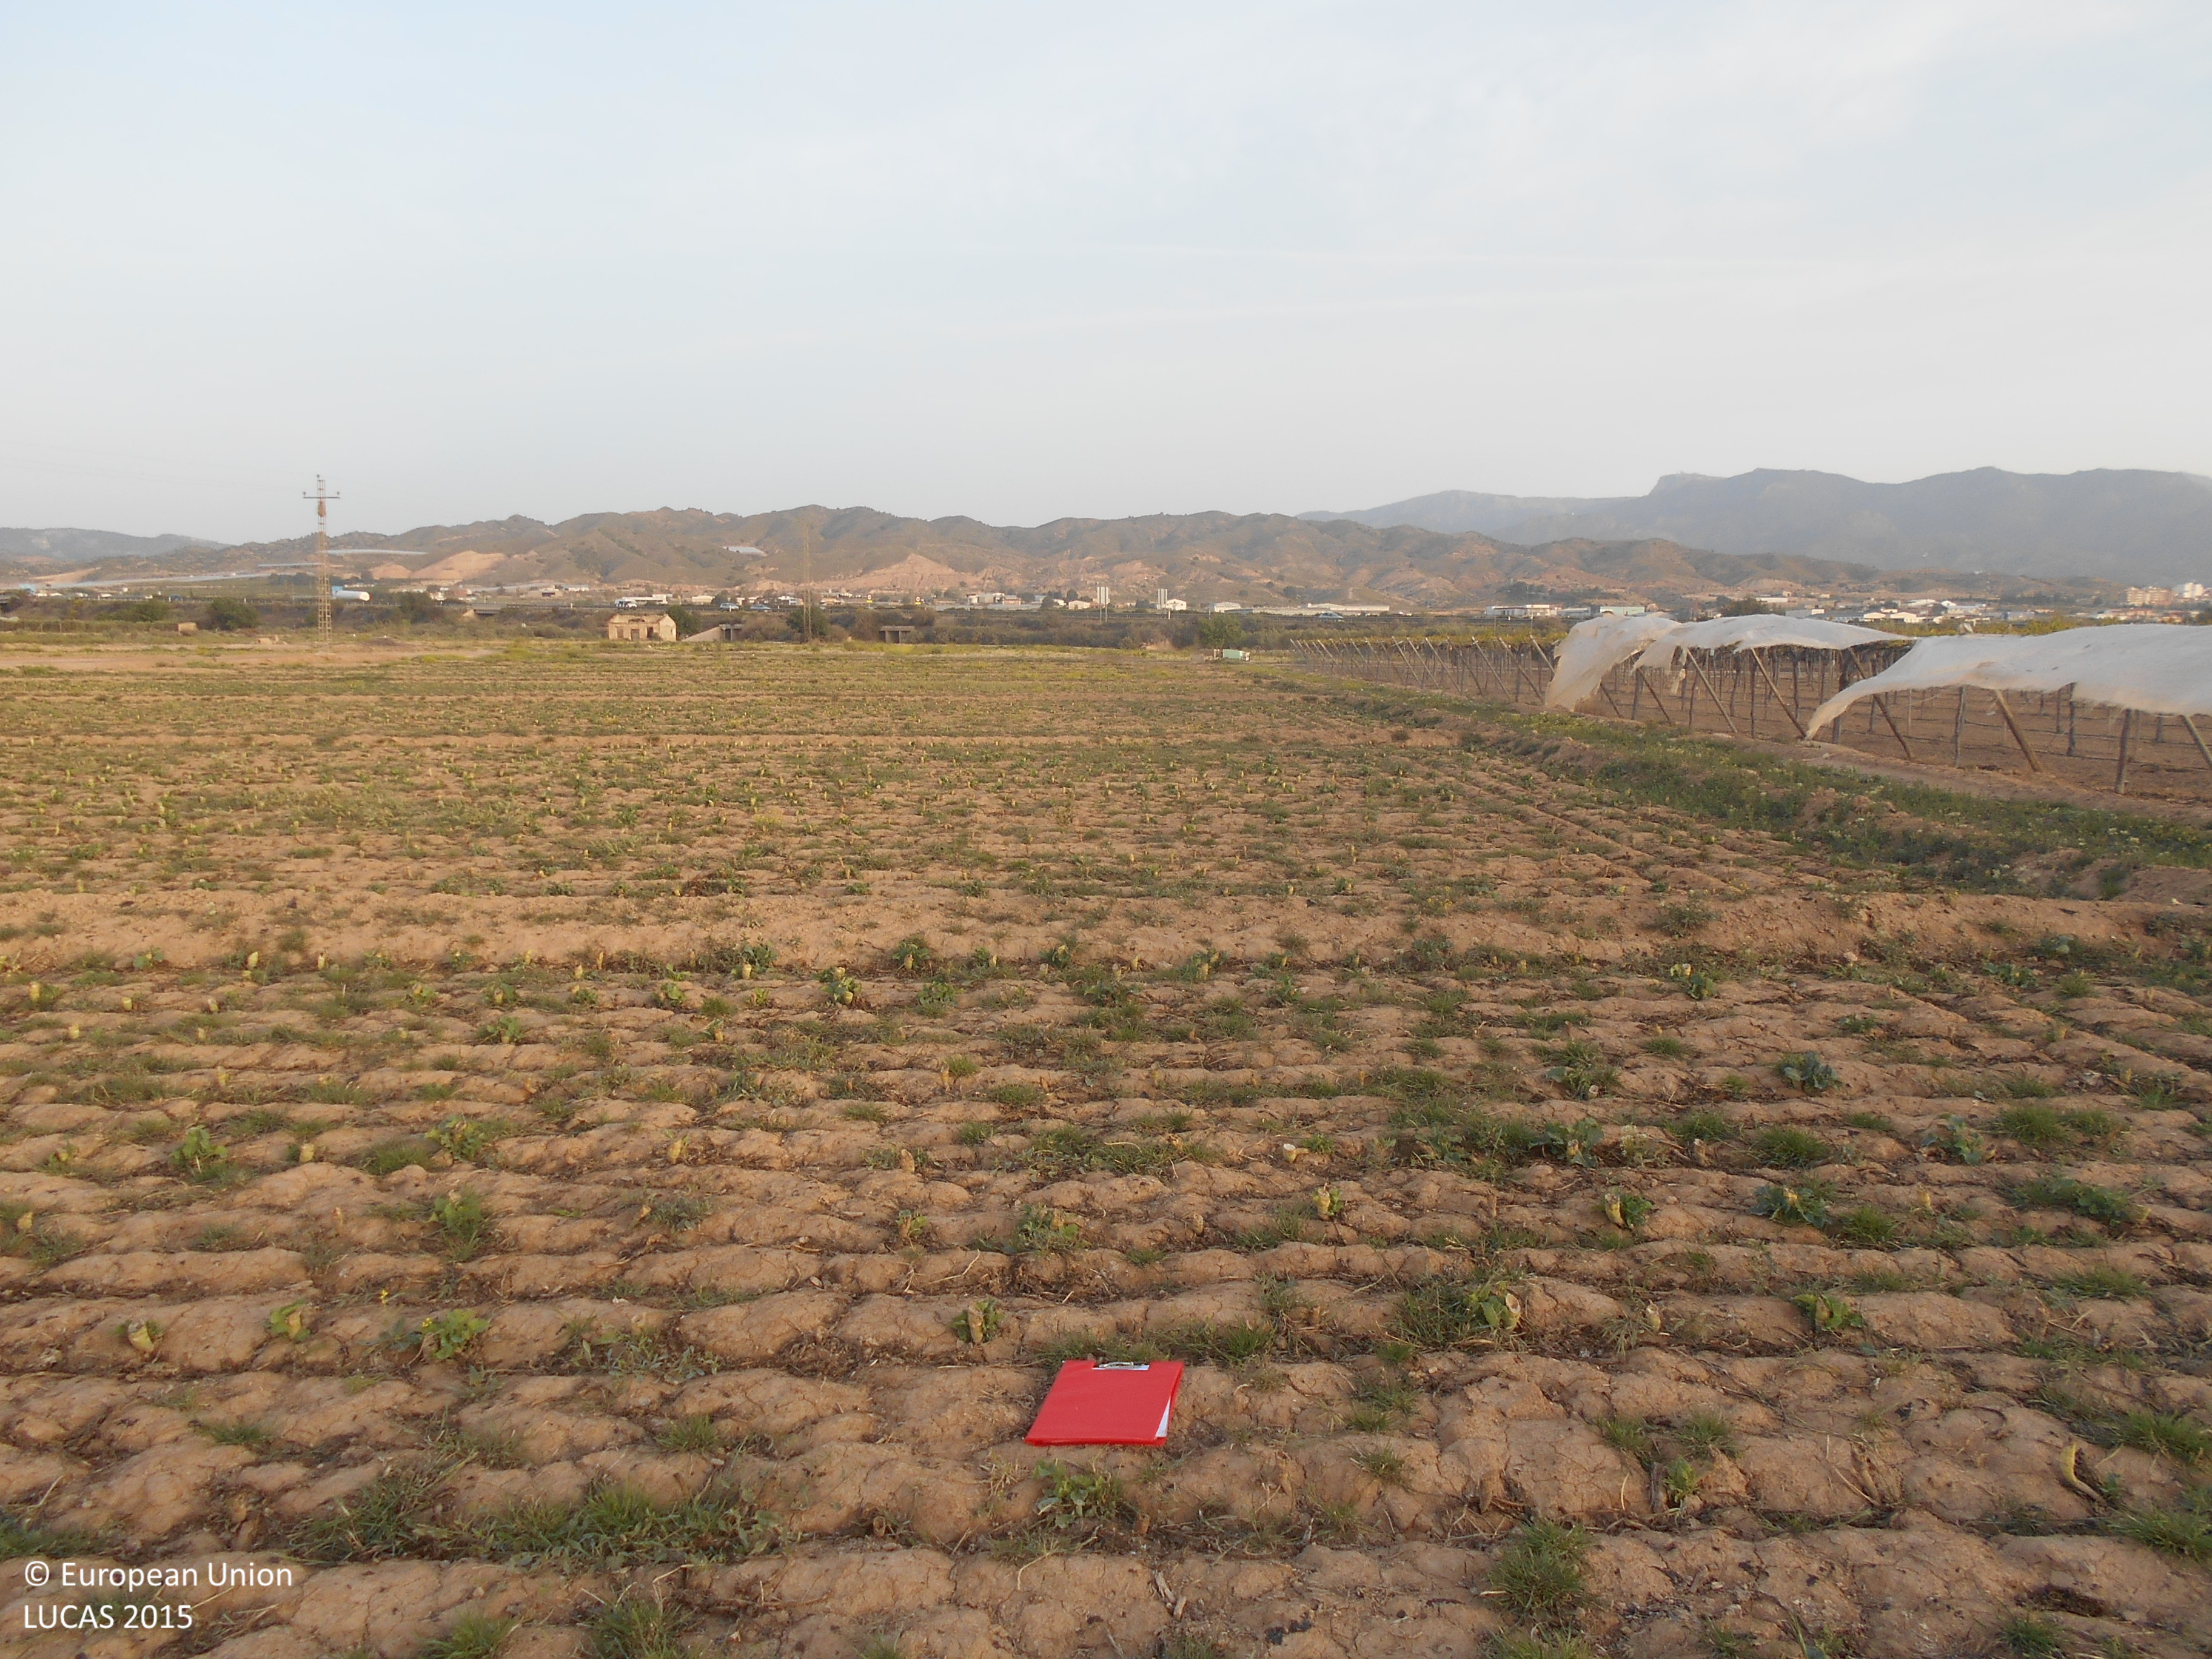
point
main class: Grassland
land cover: Spontaneously vegetated surfaces
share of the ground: 10 - 25 %
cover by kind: unconsolidated bare surface 80 %, herbaceous plants 20 %
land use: Fallow land
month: April
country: ES
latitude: 37.7426
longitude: -1.5011
